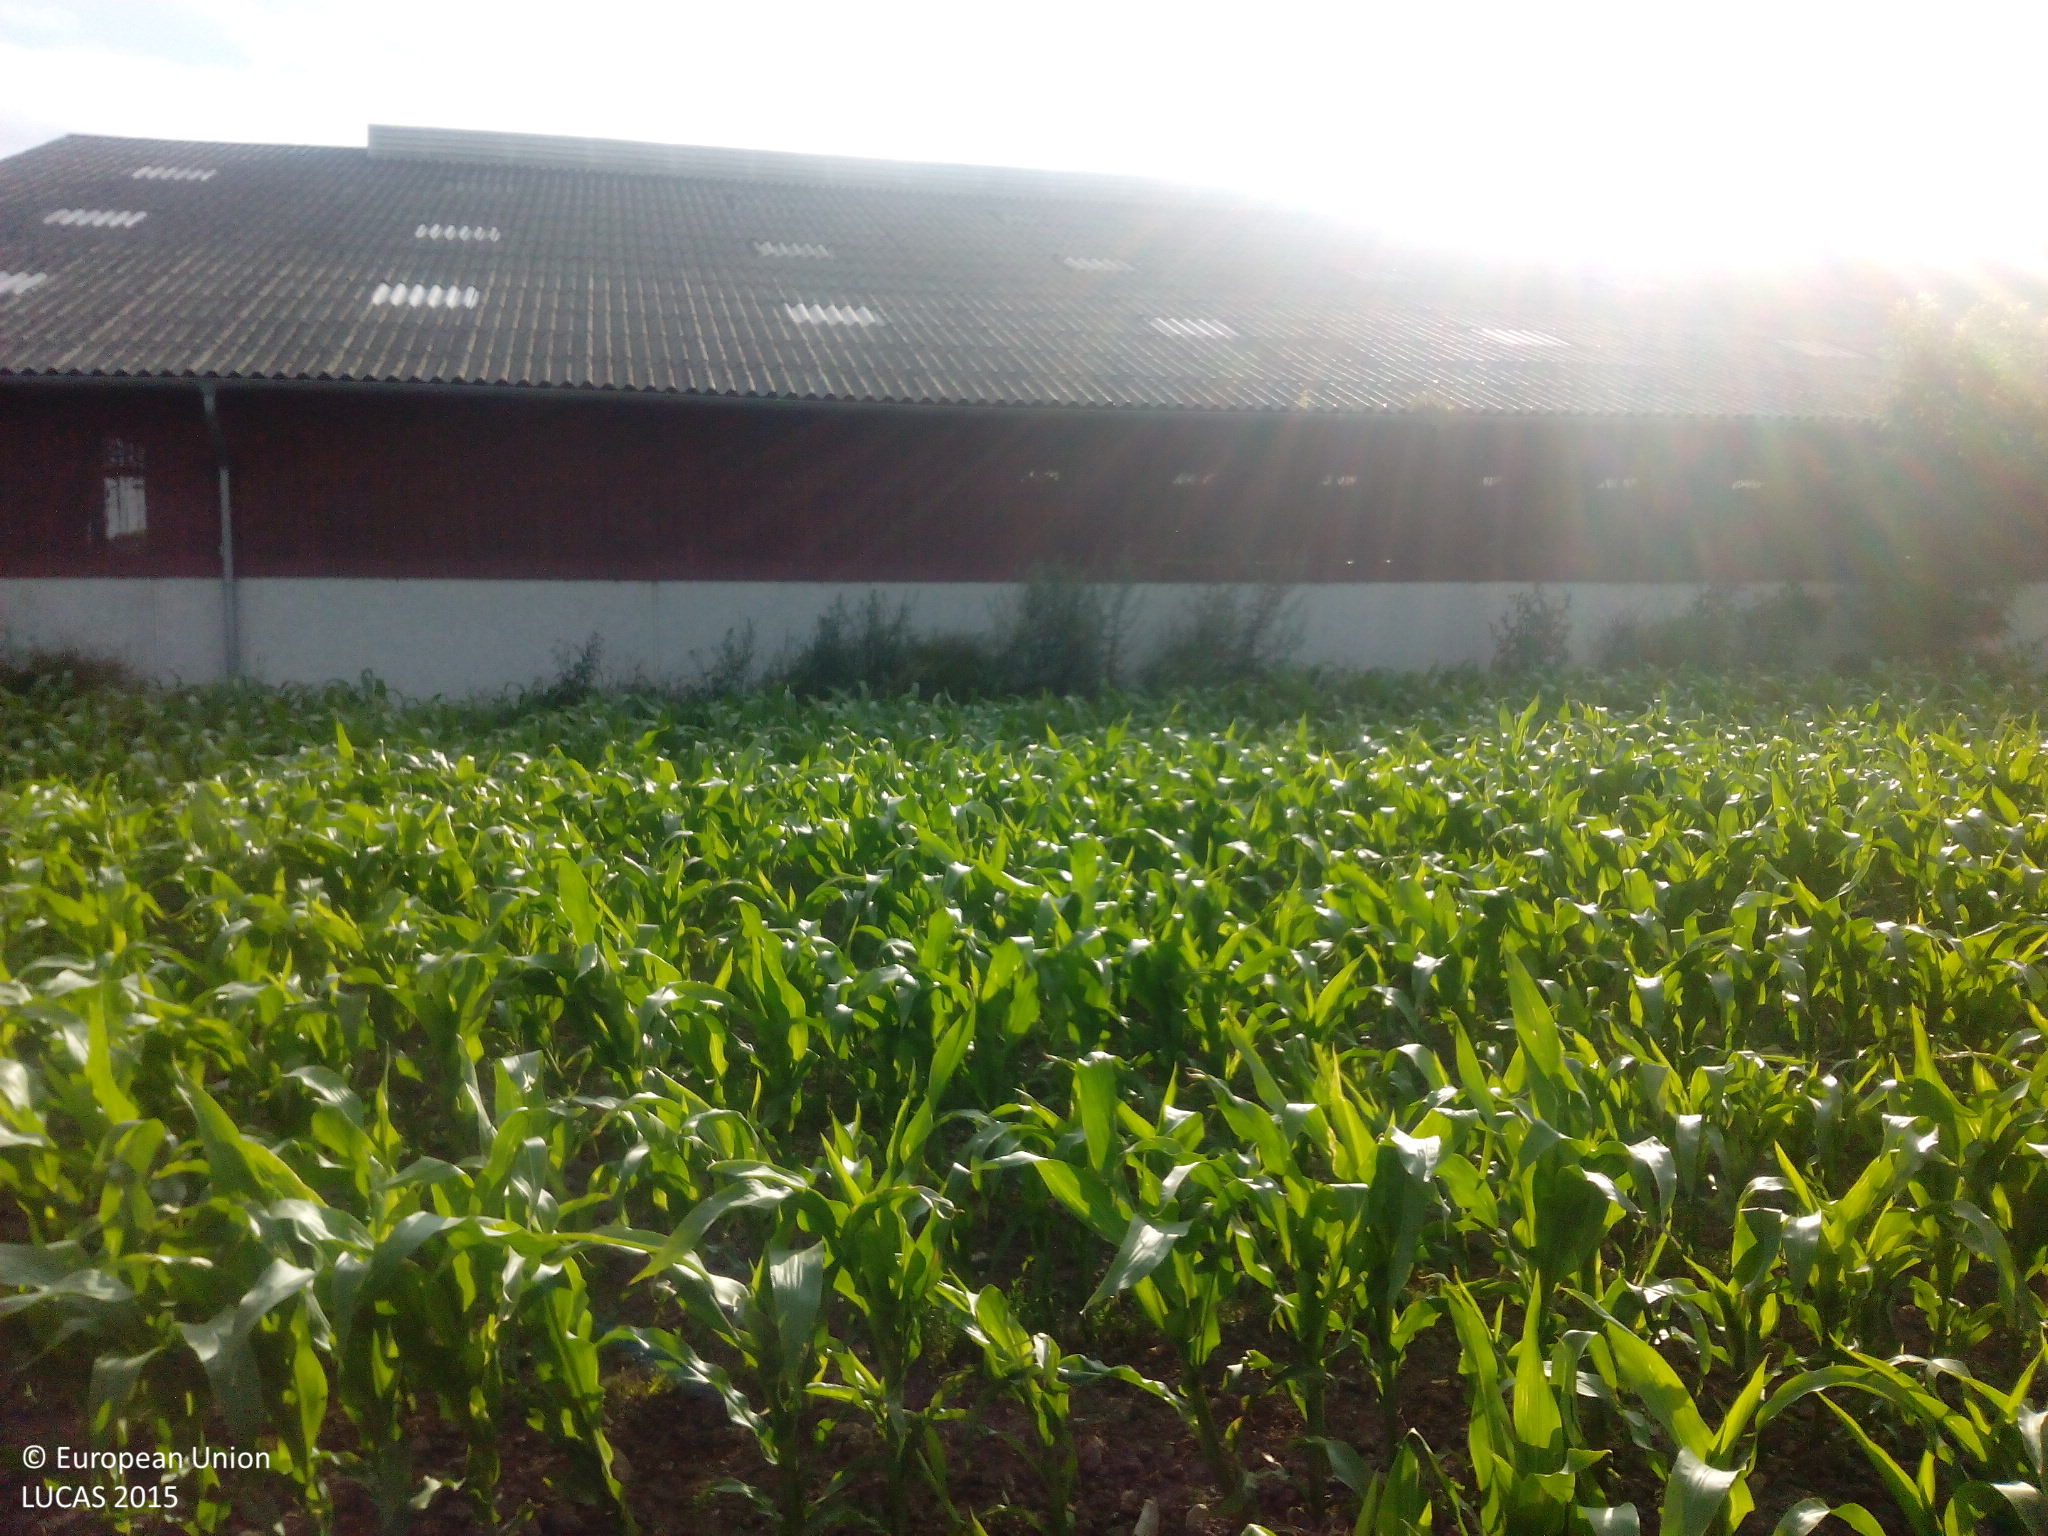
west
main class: Cropland
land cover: Maize
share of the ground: > 75 %
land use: Agriculture (excluding fallow land and kitchen gardens)
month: July
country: DK
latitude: 55.3728
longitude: 11.2455
